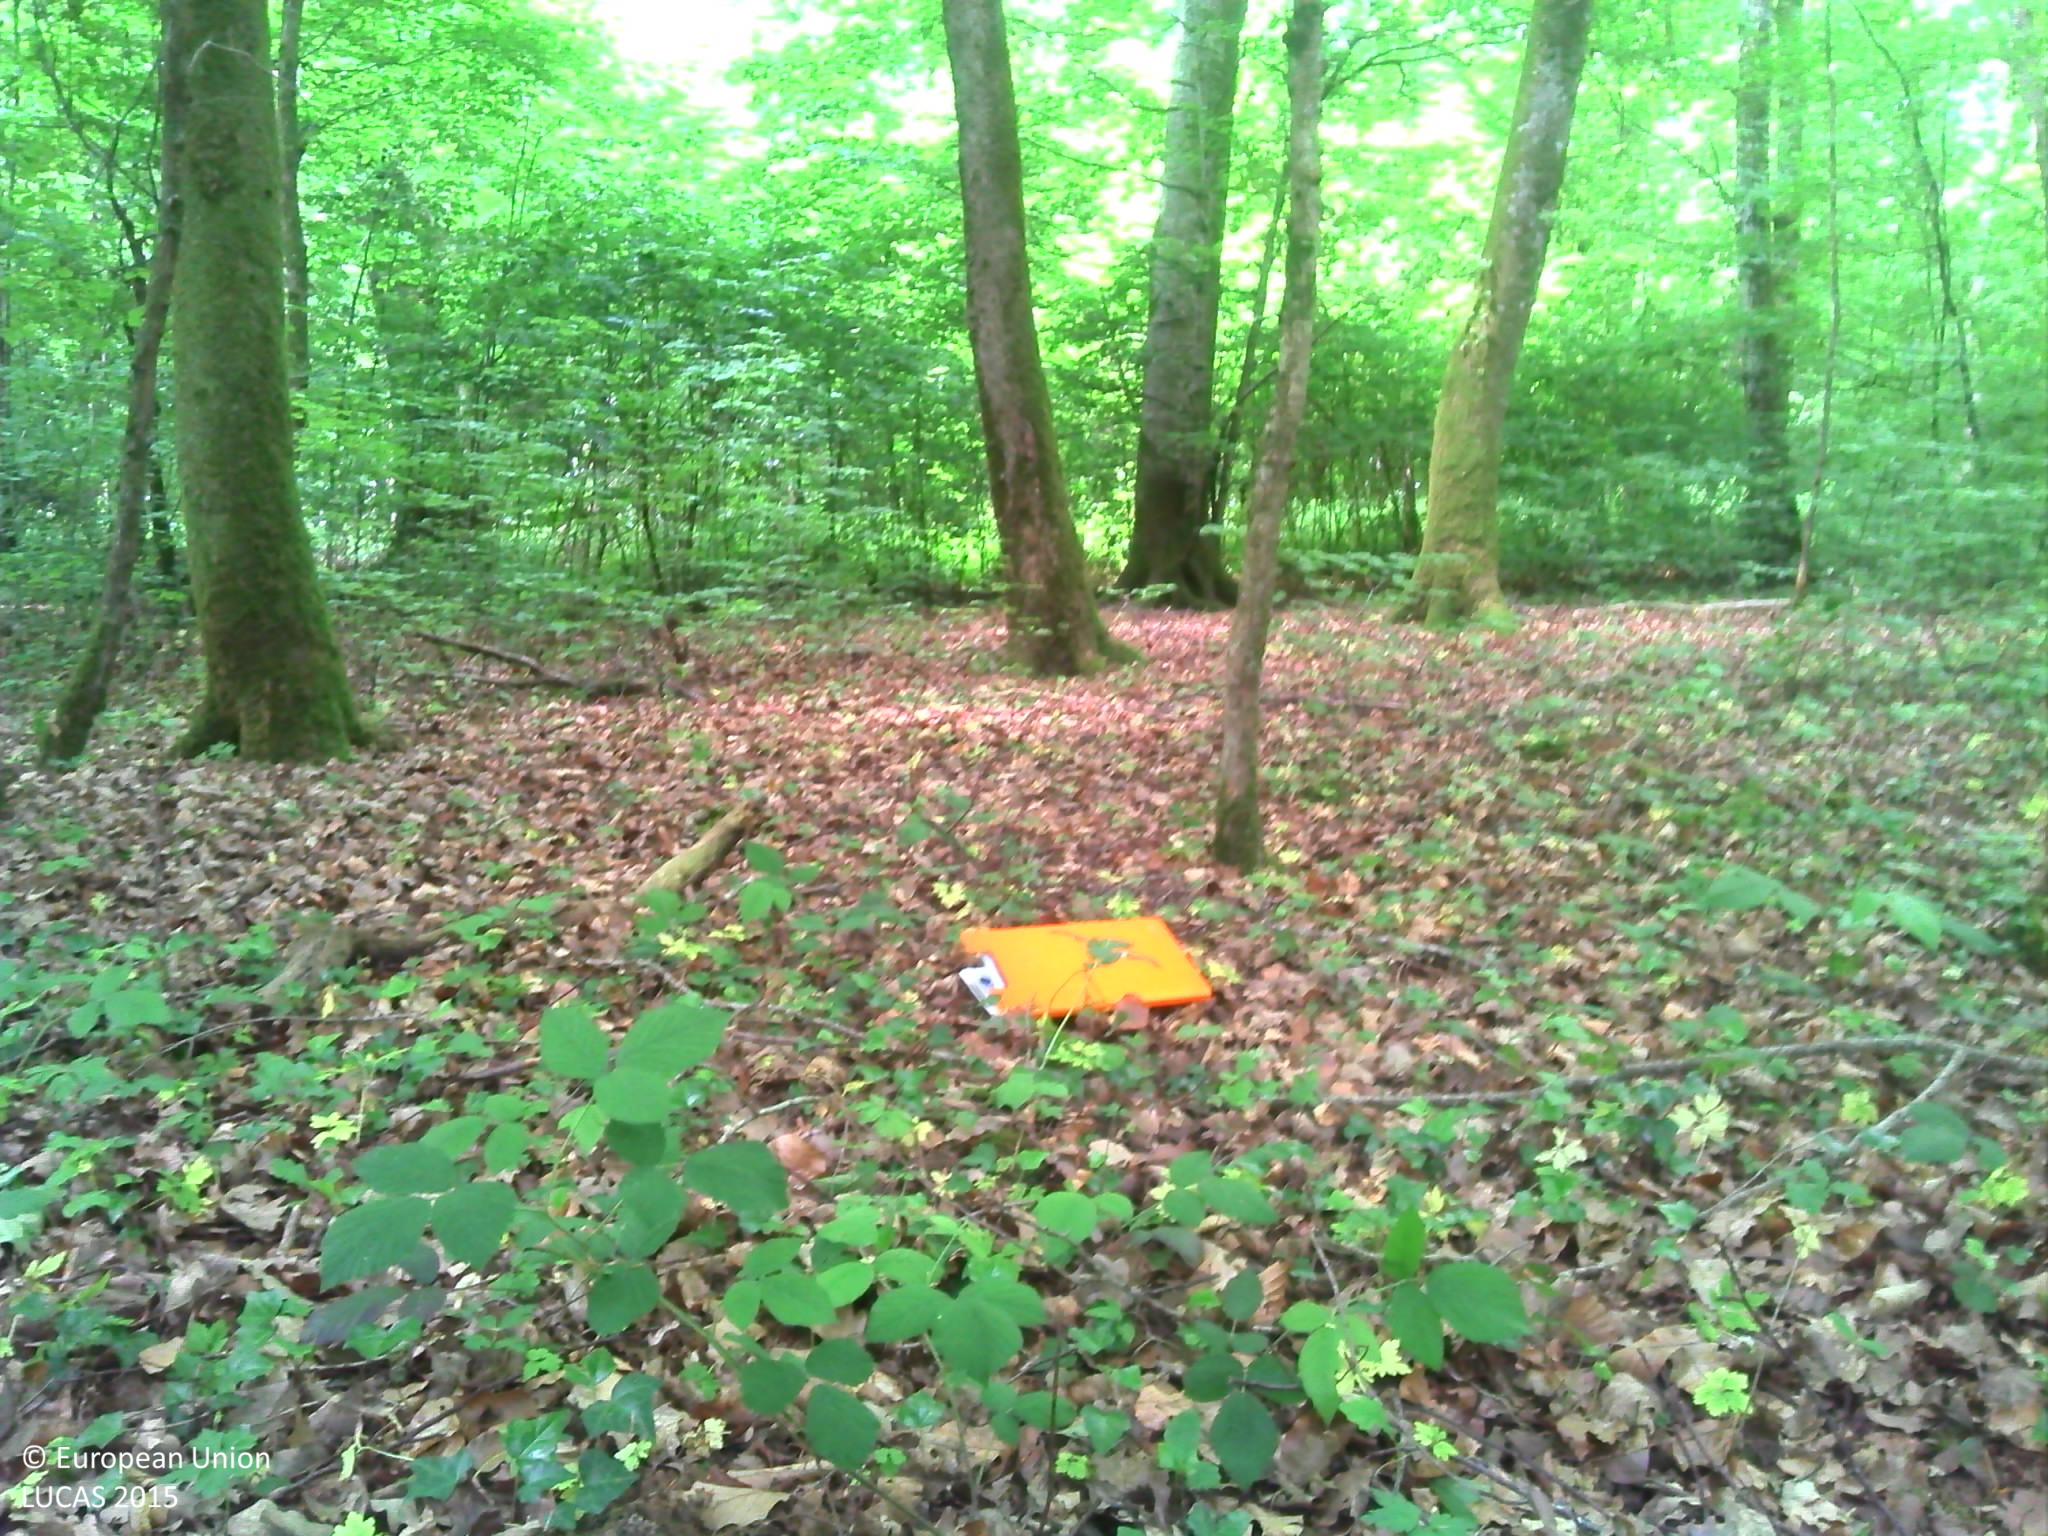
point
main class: Woodland
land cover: Broadleaved woodland
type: beech forest
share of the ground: > 75 %
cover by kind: broadleaved forest trees 95 %, herbaceous plants 5 %
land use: Forestry
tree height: > 5 m
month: May
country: FR
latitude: 47.6412
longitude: 5.4082
